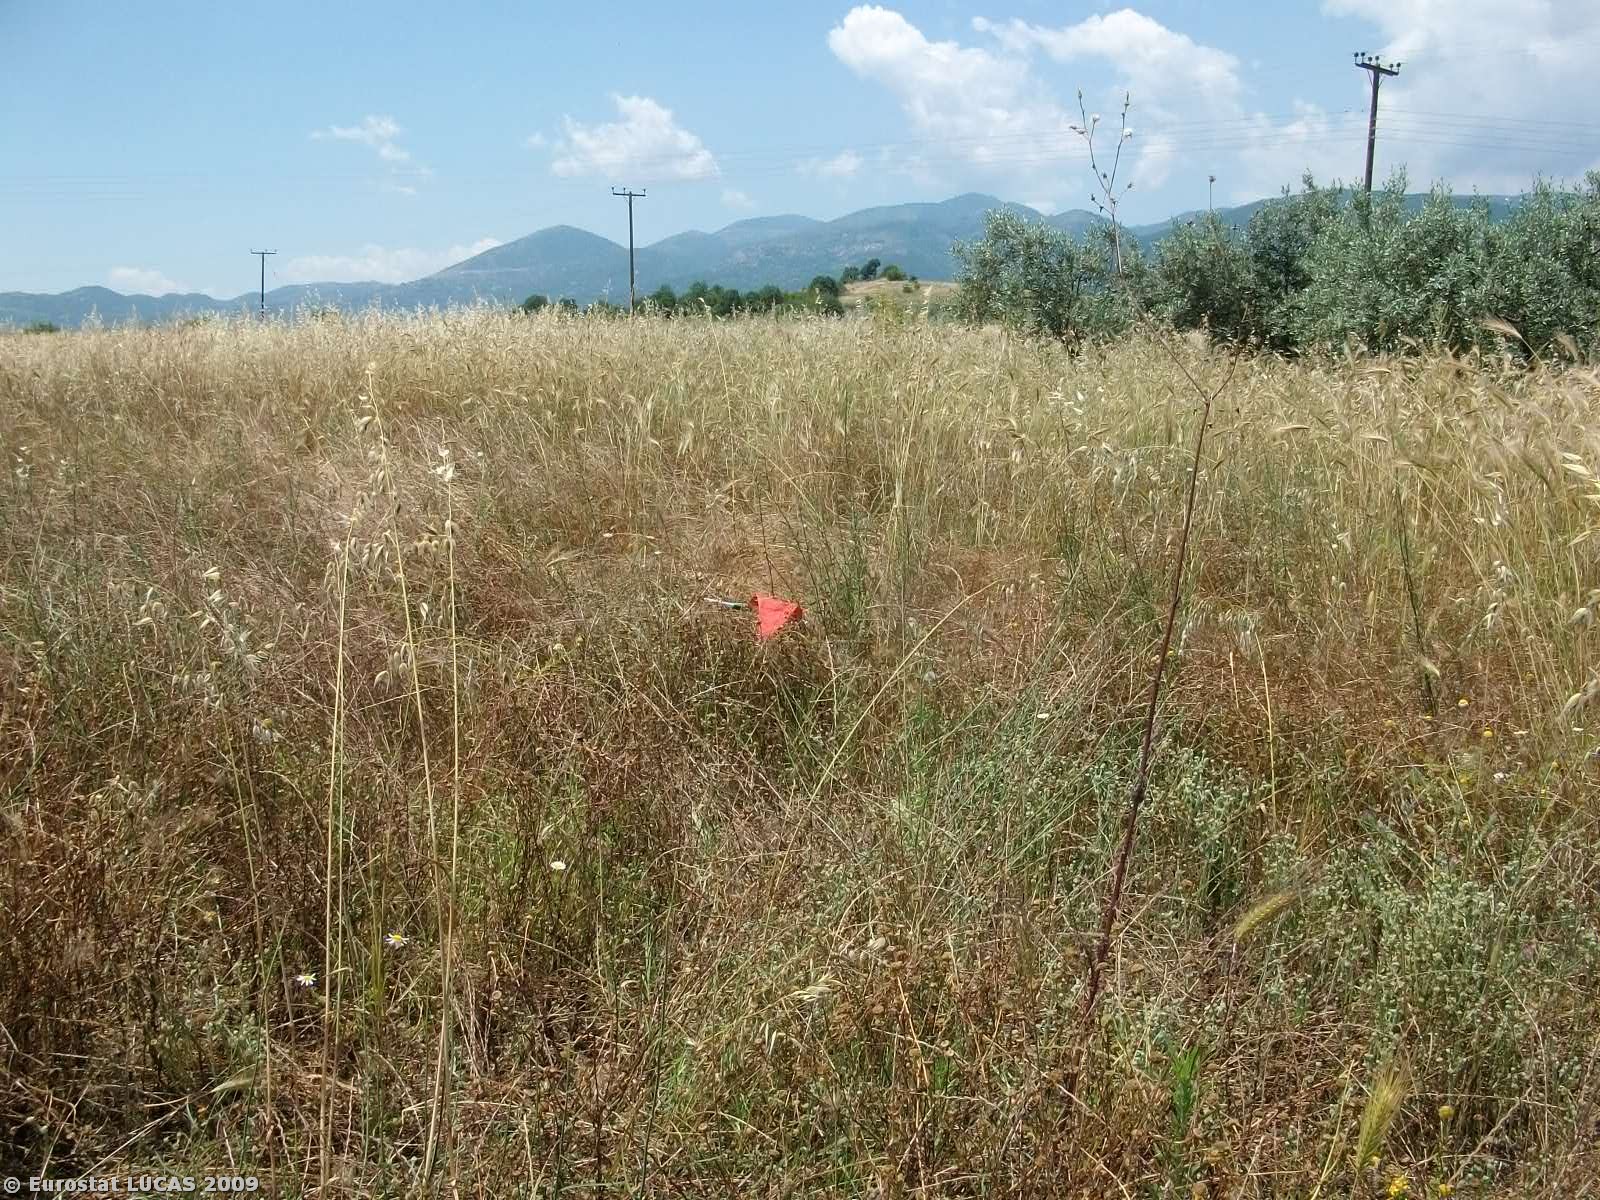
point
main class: Grassland
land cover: Grassland without tree/shrub cover
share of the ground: > 75 %
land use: Agriculture (excluding fallow land and kitchen gardens)
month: June
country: GR
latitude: 39.9392
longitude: 22.6465
